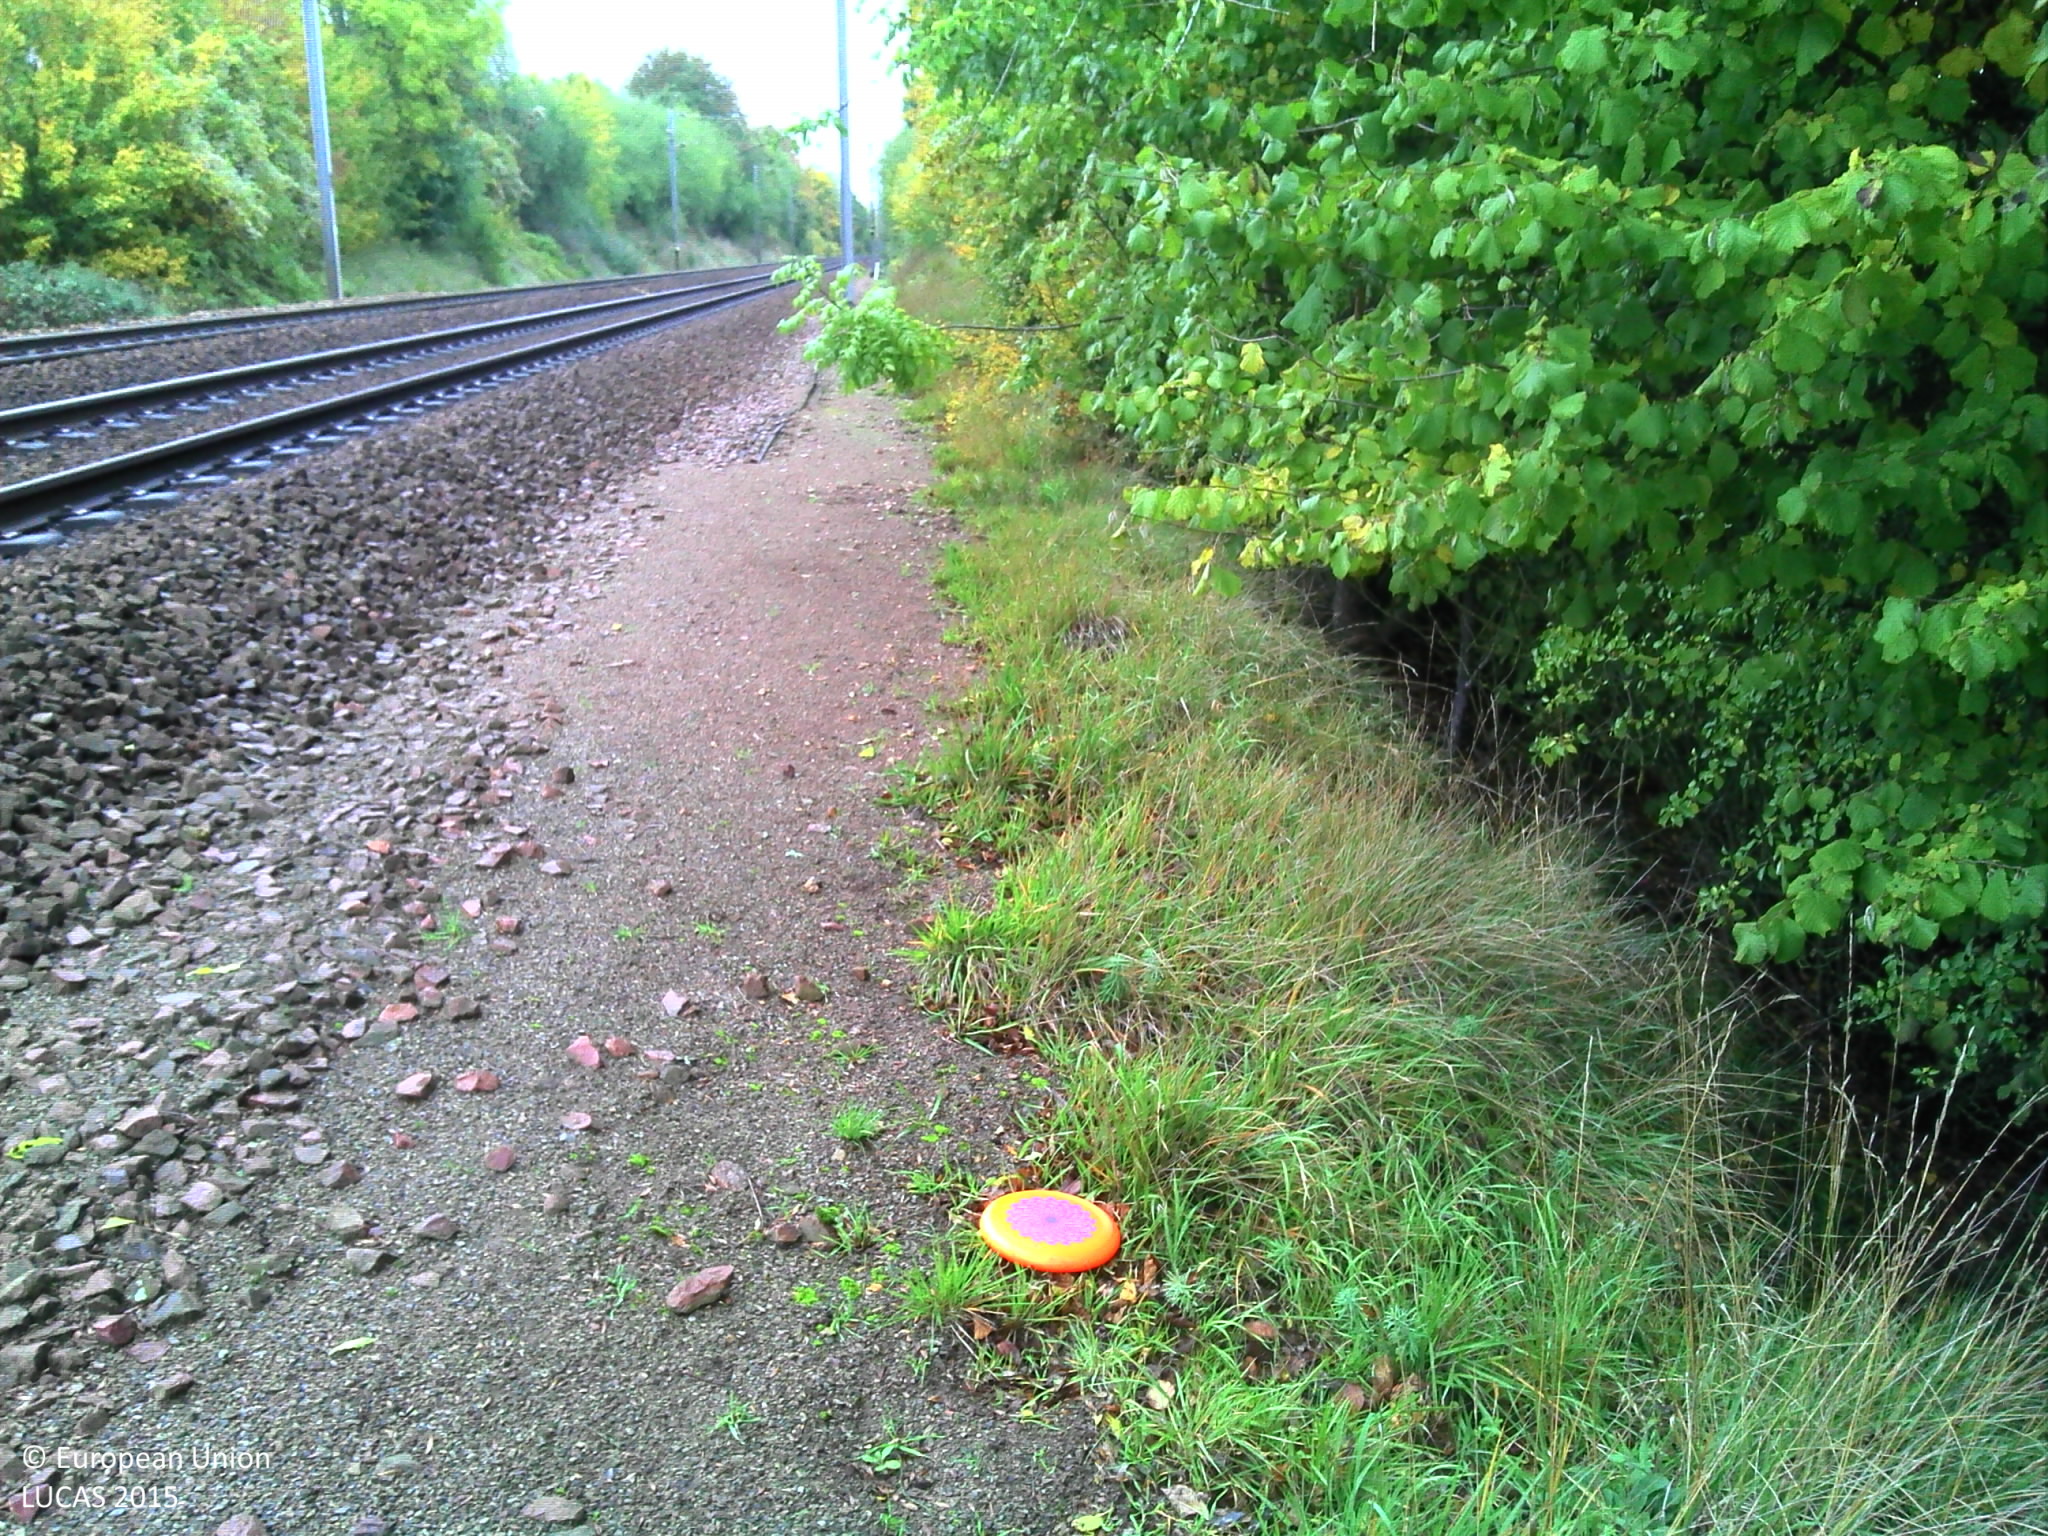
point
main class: Cropland
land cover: Other fibre and oleaginous crops
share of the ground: 50 - 75 %
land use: Agriculture (excluding fallow land and kitchen gardens)
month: October
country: FR
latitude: 48.8278
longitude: 1.8801
